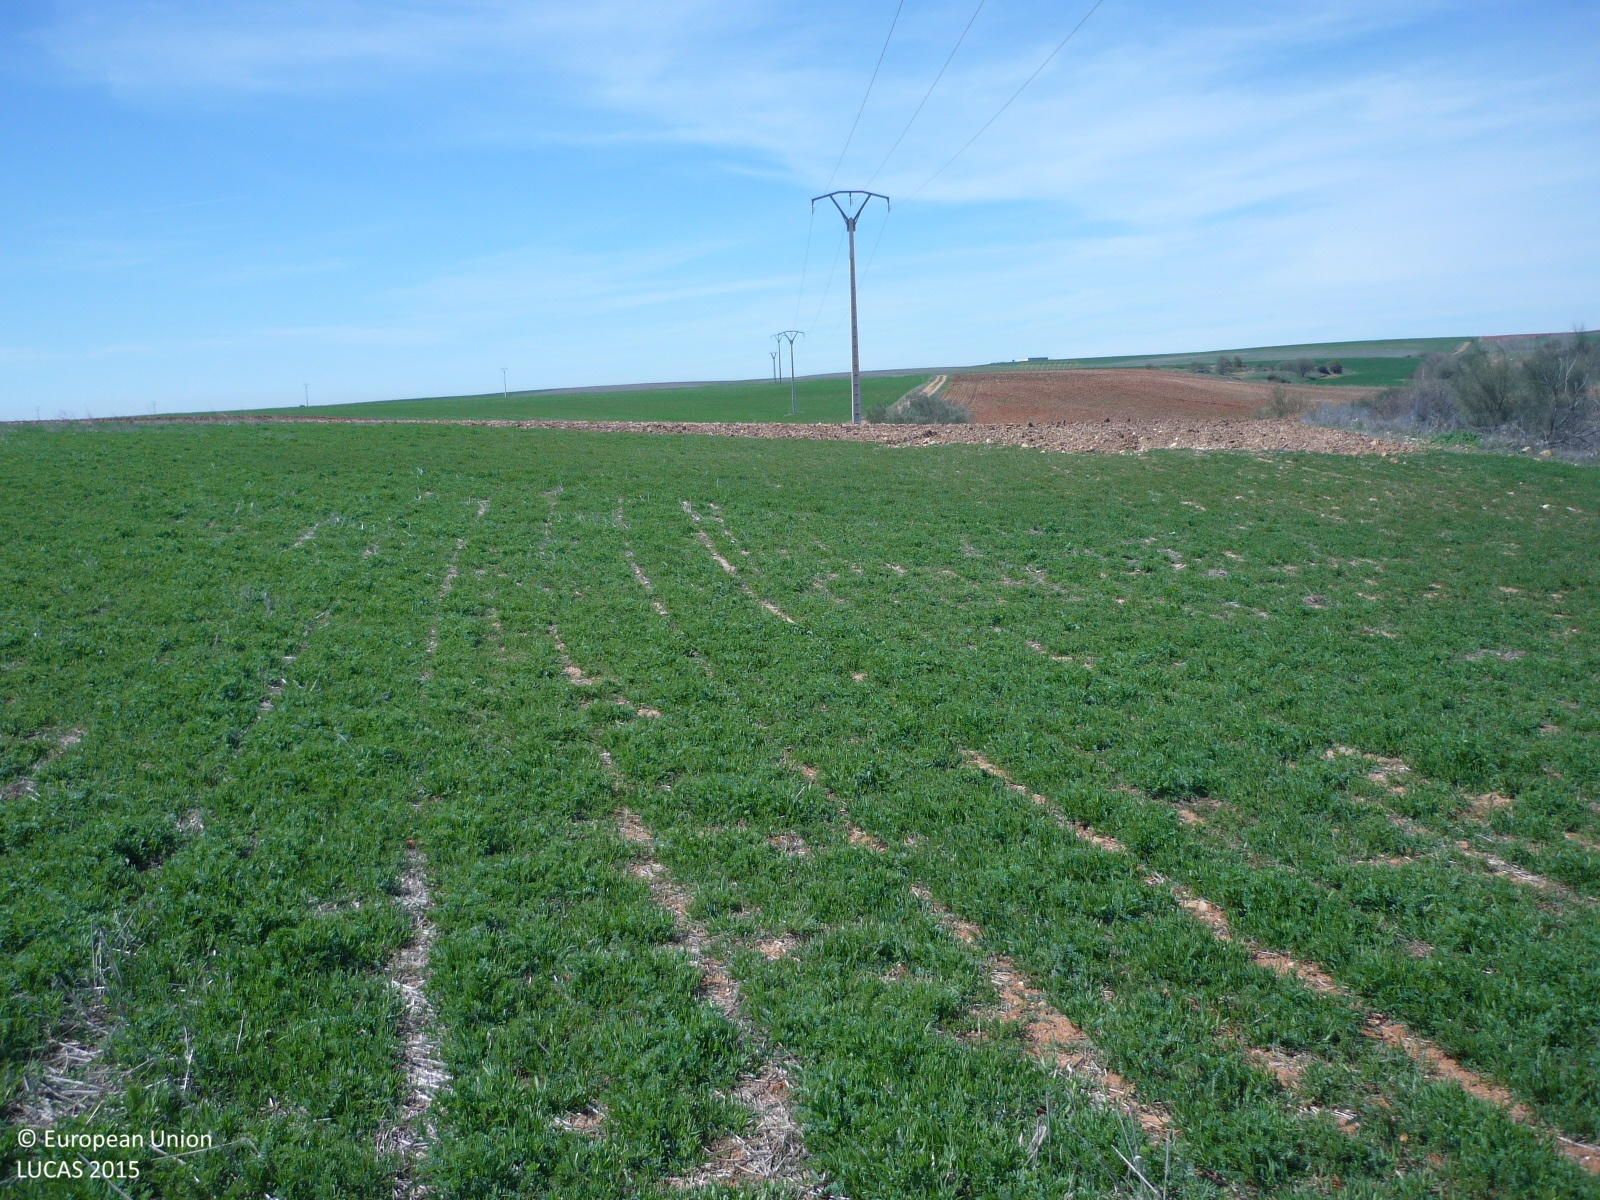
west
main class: Cropland
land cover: Dry pulses
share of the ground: > 75 %
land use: Agriculture (excluding fallow land and kitchen gardens)
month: March
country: ES
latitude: 40.6045
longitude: -3.2826
